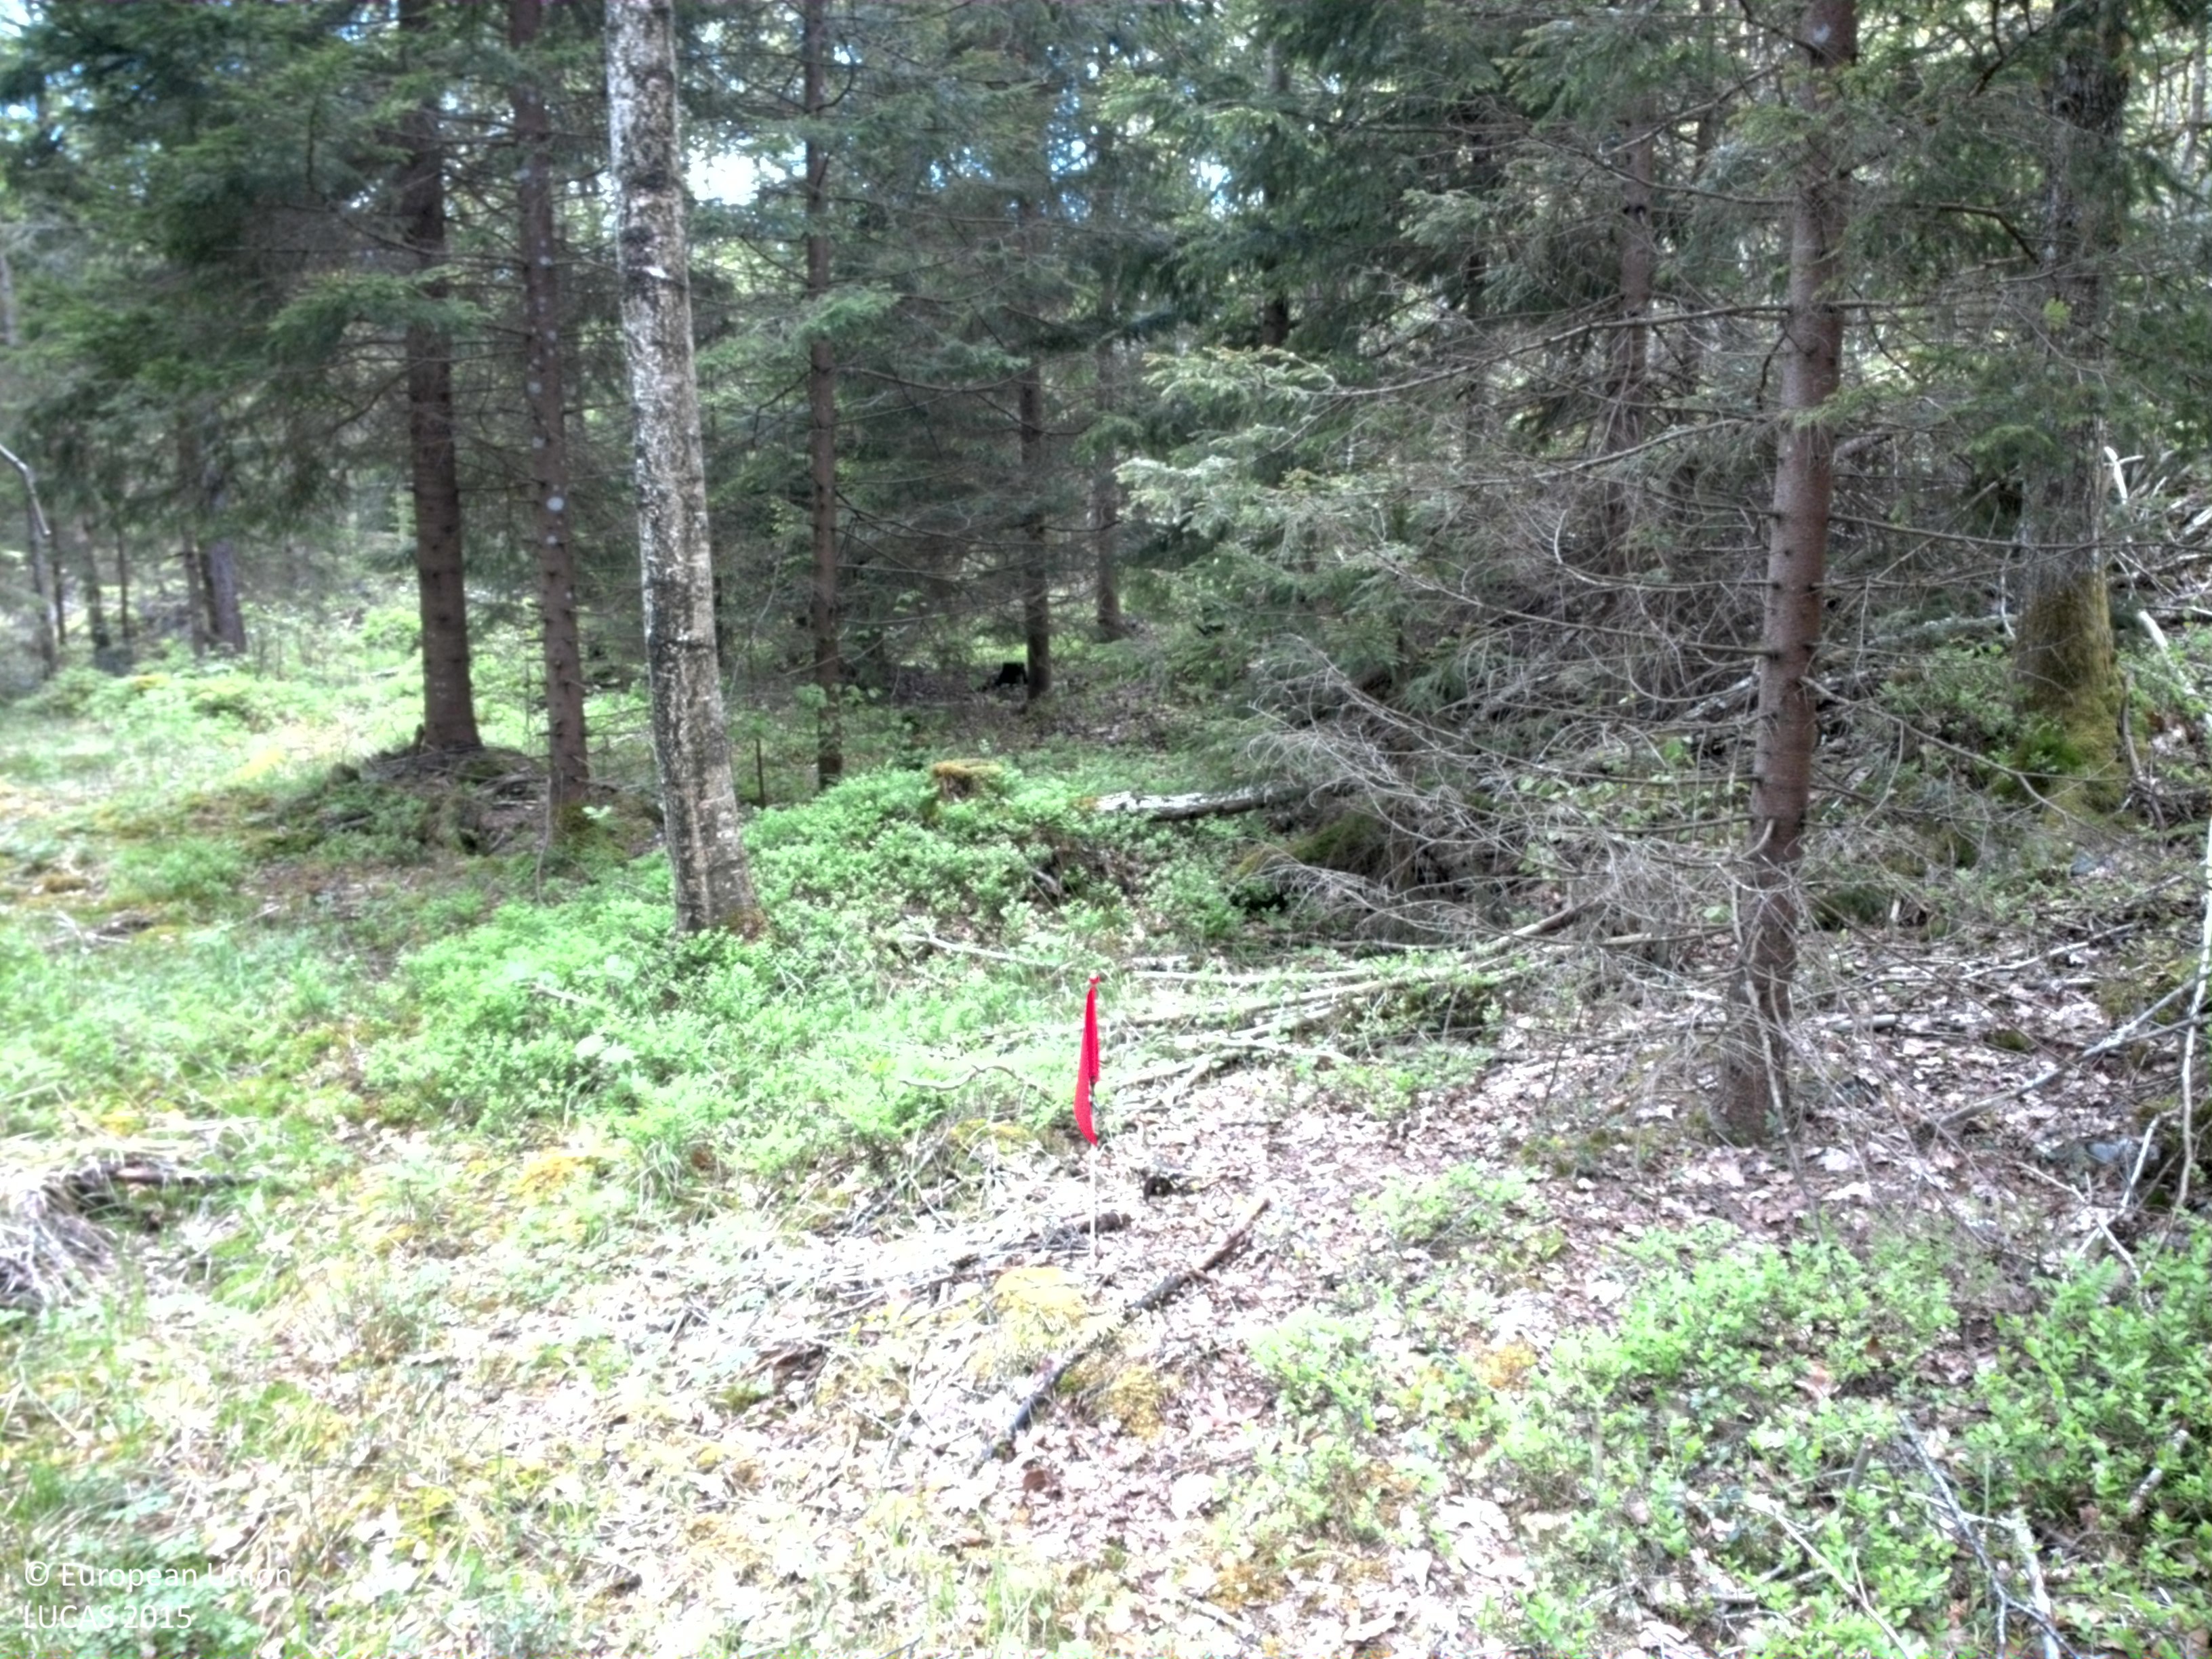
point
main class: Woodland
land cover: Spruce dominated mixed woodland
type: boreal forest
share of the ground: > 75 %
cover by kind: coniferous forest trees 60 %, broadleaved forest trees 25 %, herbaceous plants 15 %
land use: Forestry
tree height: > 5 m
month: May
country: SE
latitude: 58.6325
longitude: 12.2516
